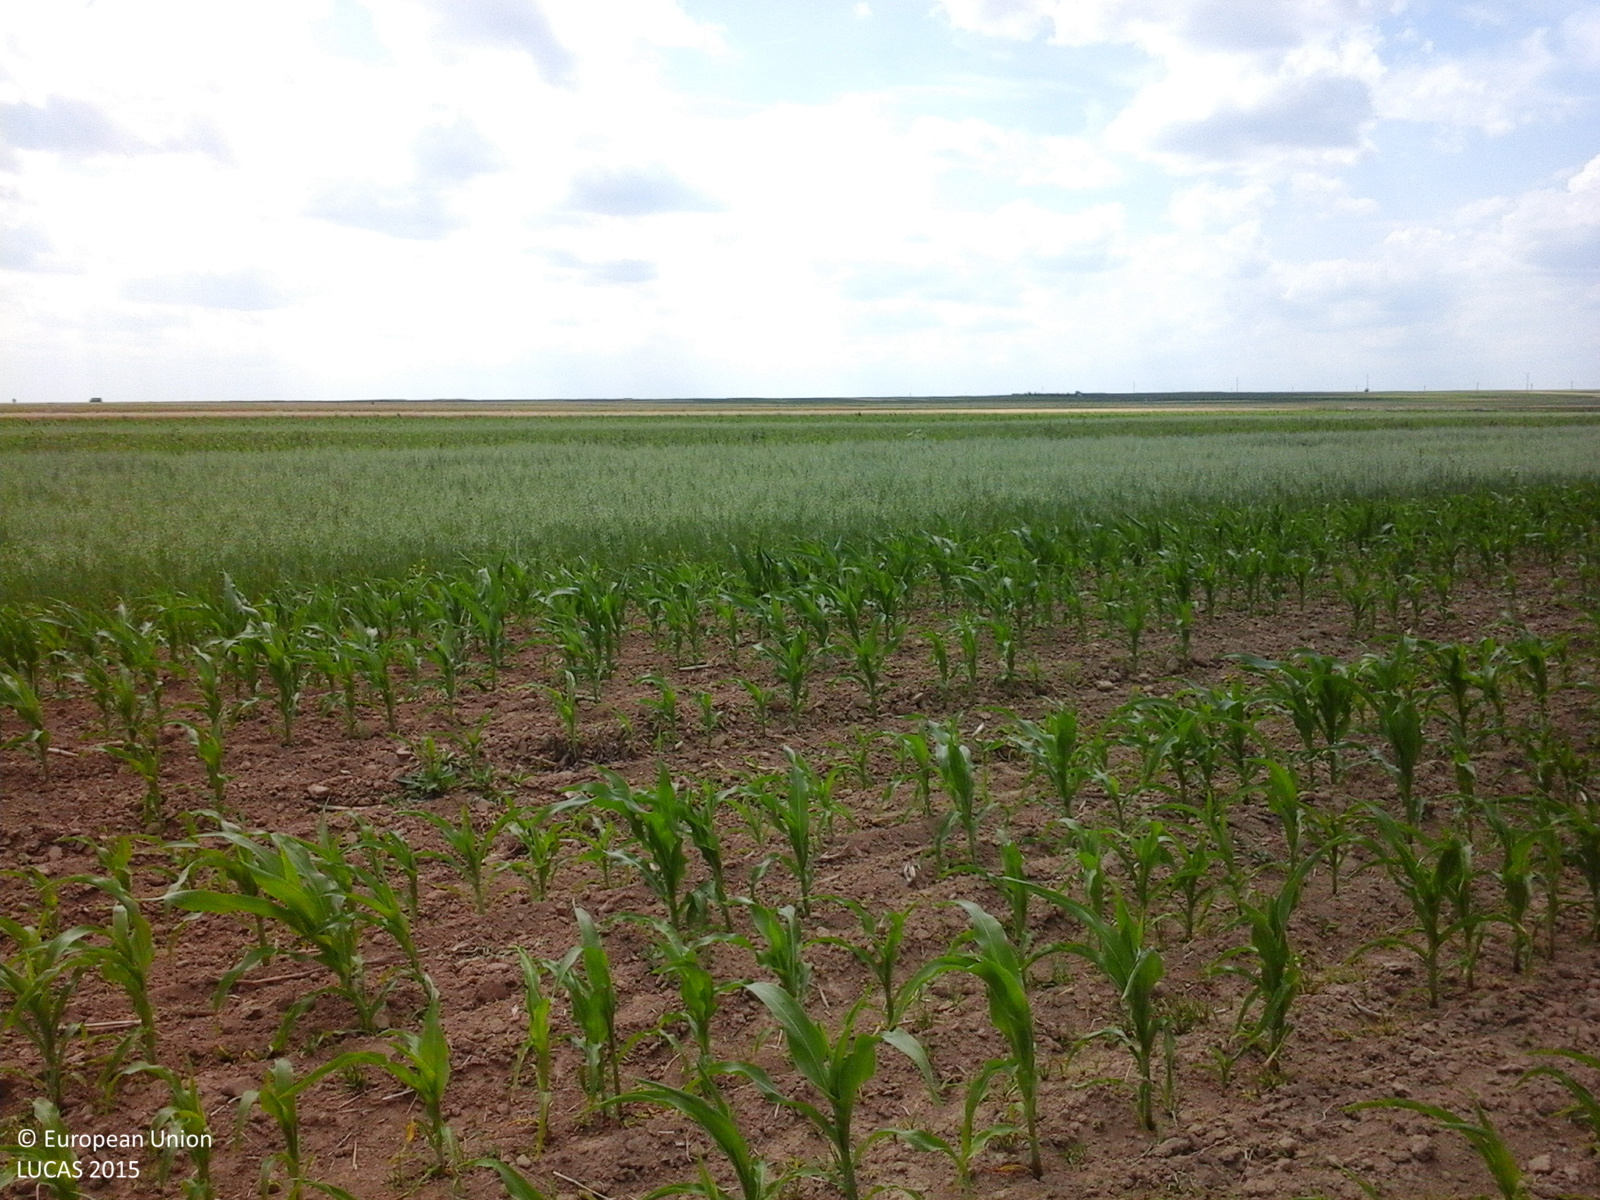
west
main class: Cropland
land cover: Maize
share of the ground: 25 - 50 %
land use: Agriculture (excluding fallow land and kitchen gardens)
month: June
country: RO
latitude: 47.6381
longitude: 26.4464
